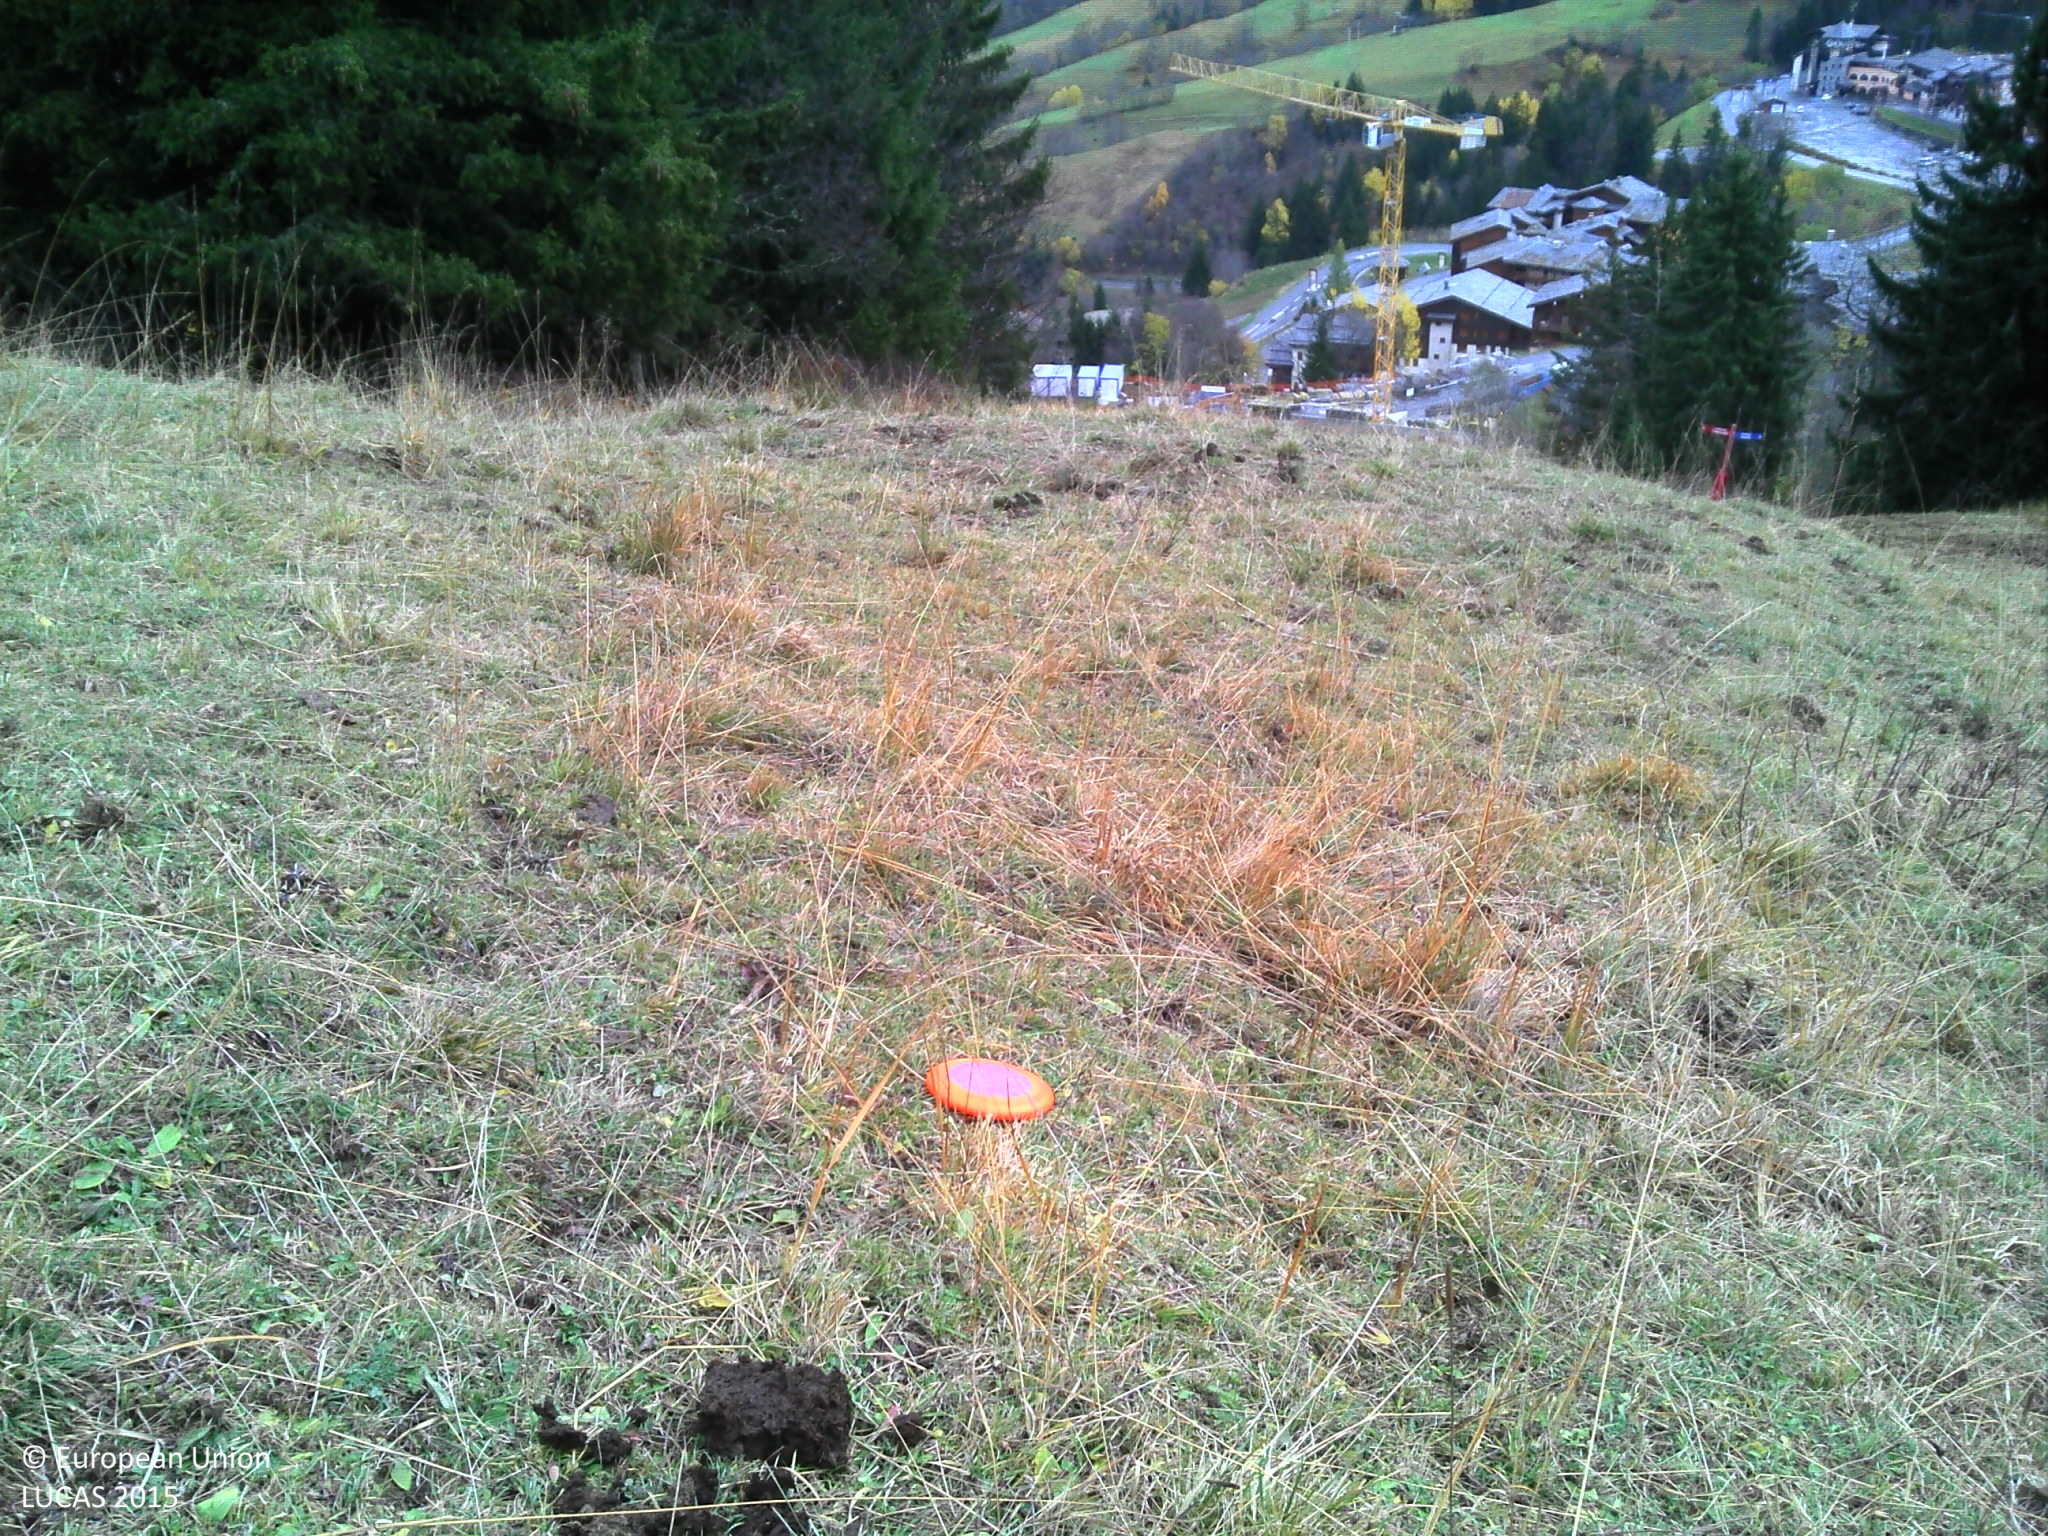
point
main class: Grassland
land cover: Grassland without tree/shrub cover
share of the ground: > 75 %
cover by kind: herbaceous plants 95 %, shrubs 5 %
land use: Agriculture (excluding fallow land and kitchen gardens)
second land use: Sport
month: October
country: FR
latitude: 45.4623
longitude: 6.4365
